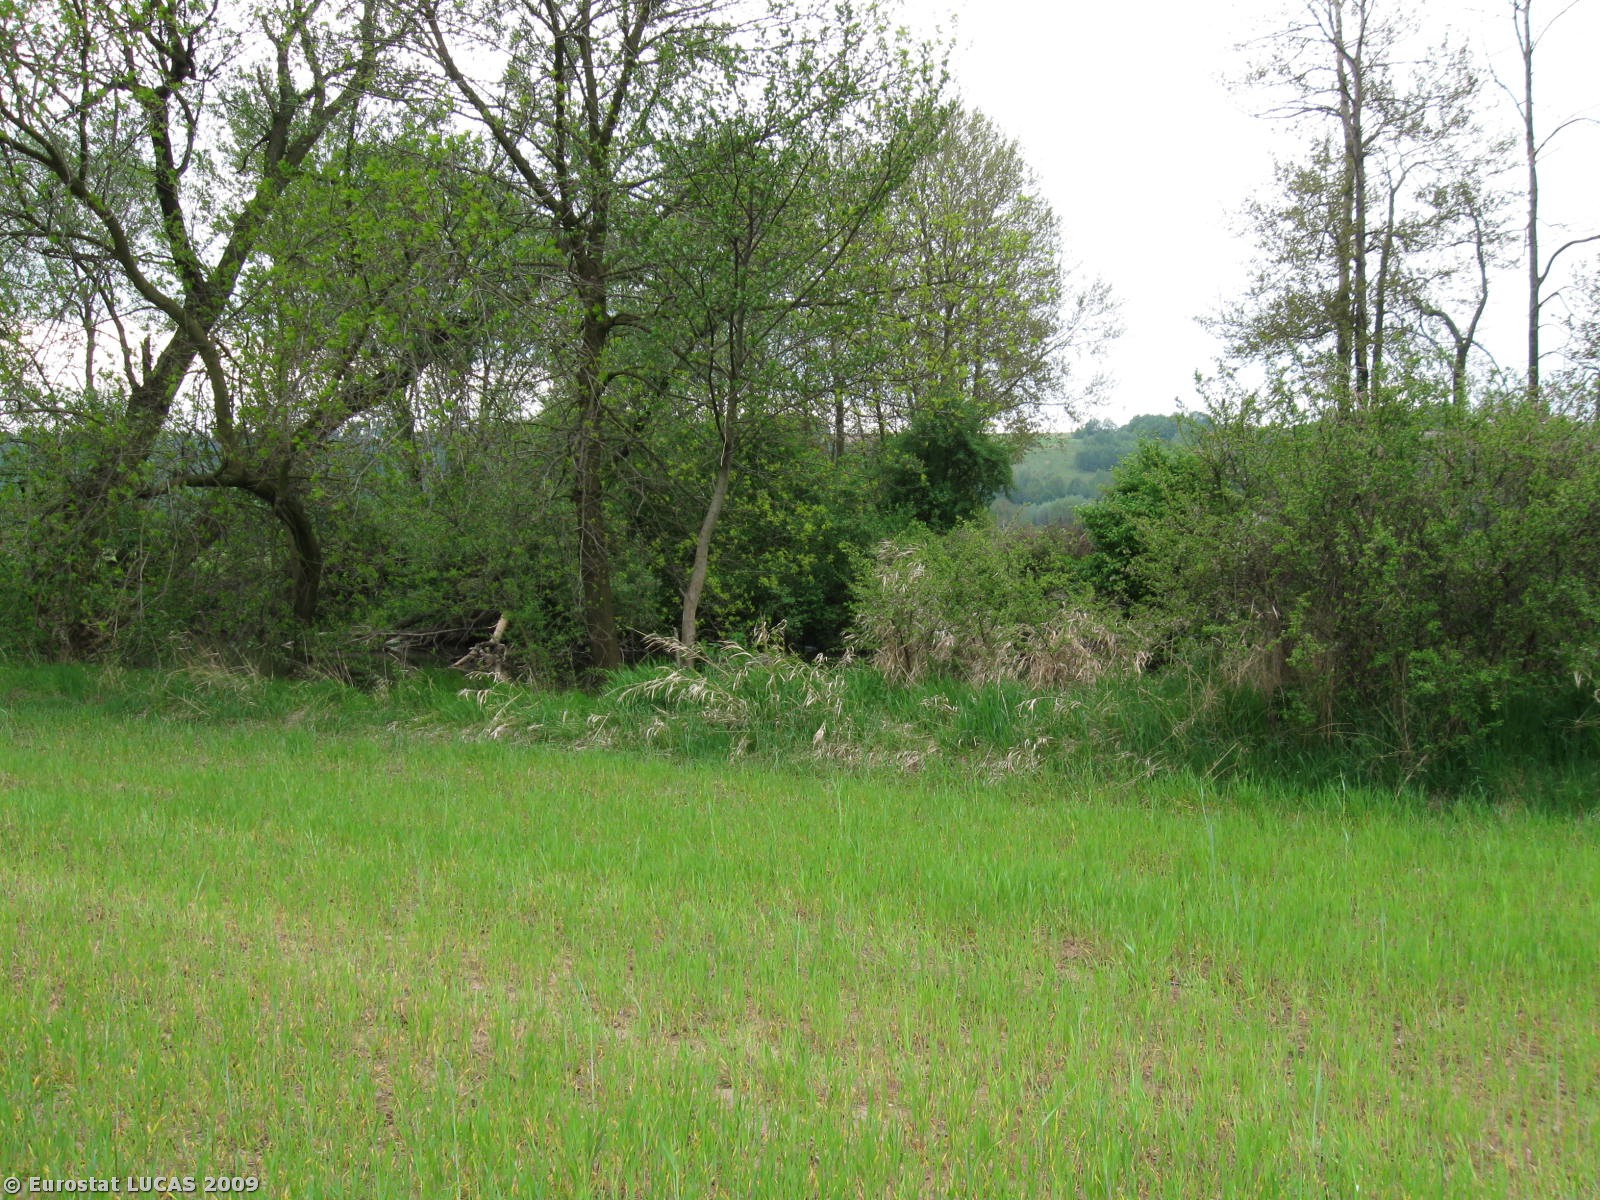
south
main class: Cropland
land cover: Rye
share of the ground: > 75 %
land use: Agriculture (excluding fallow land and kitchen gardens)
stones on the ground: < 10 %
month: May
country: PL
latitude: 50.9455
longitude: 21.3067
